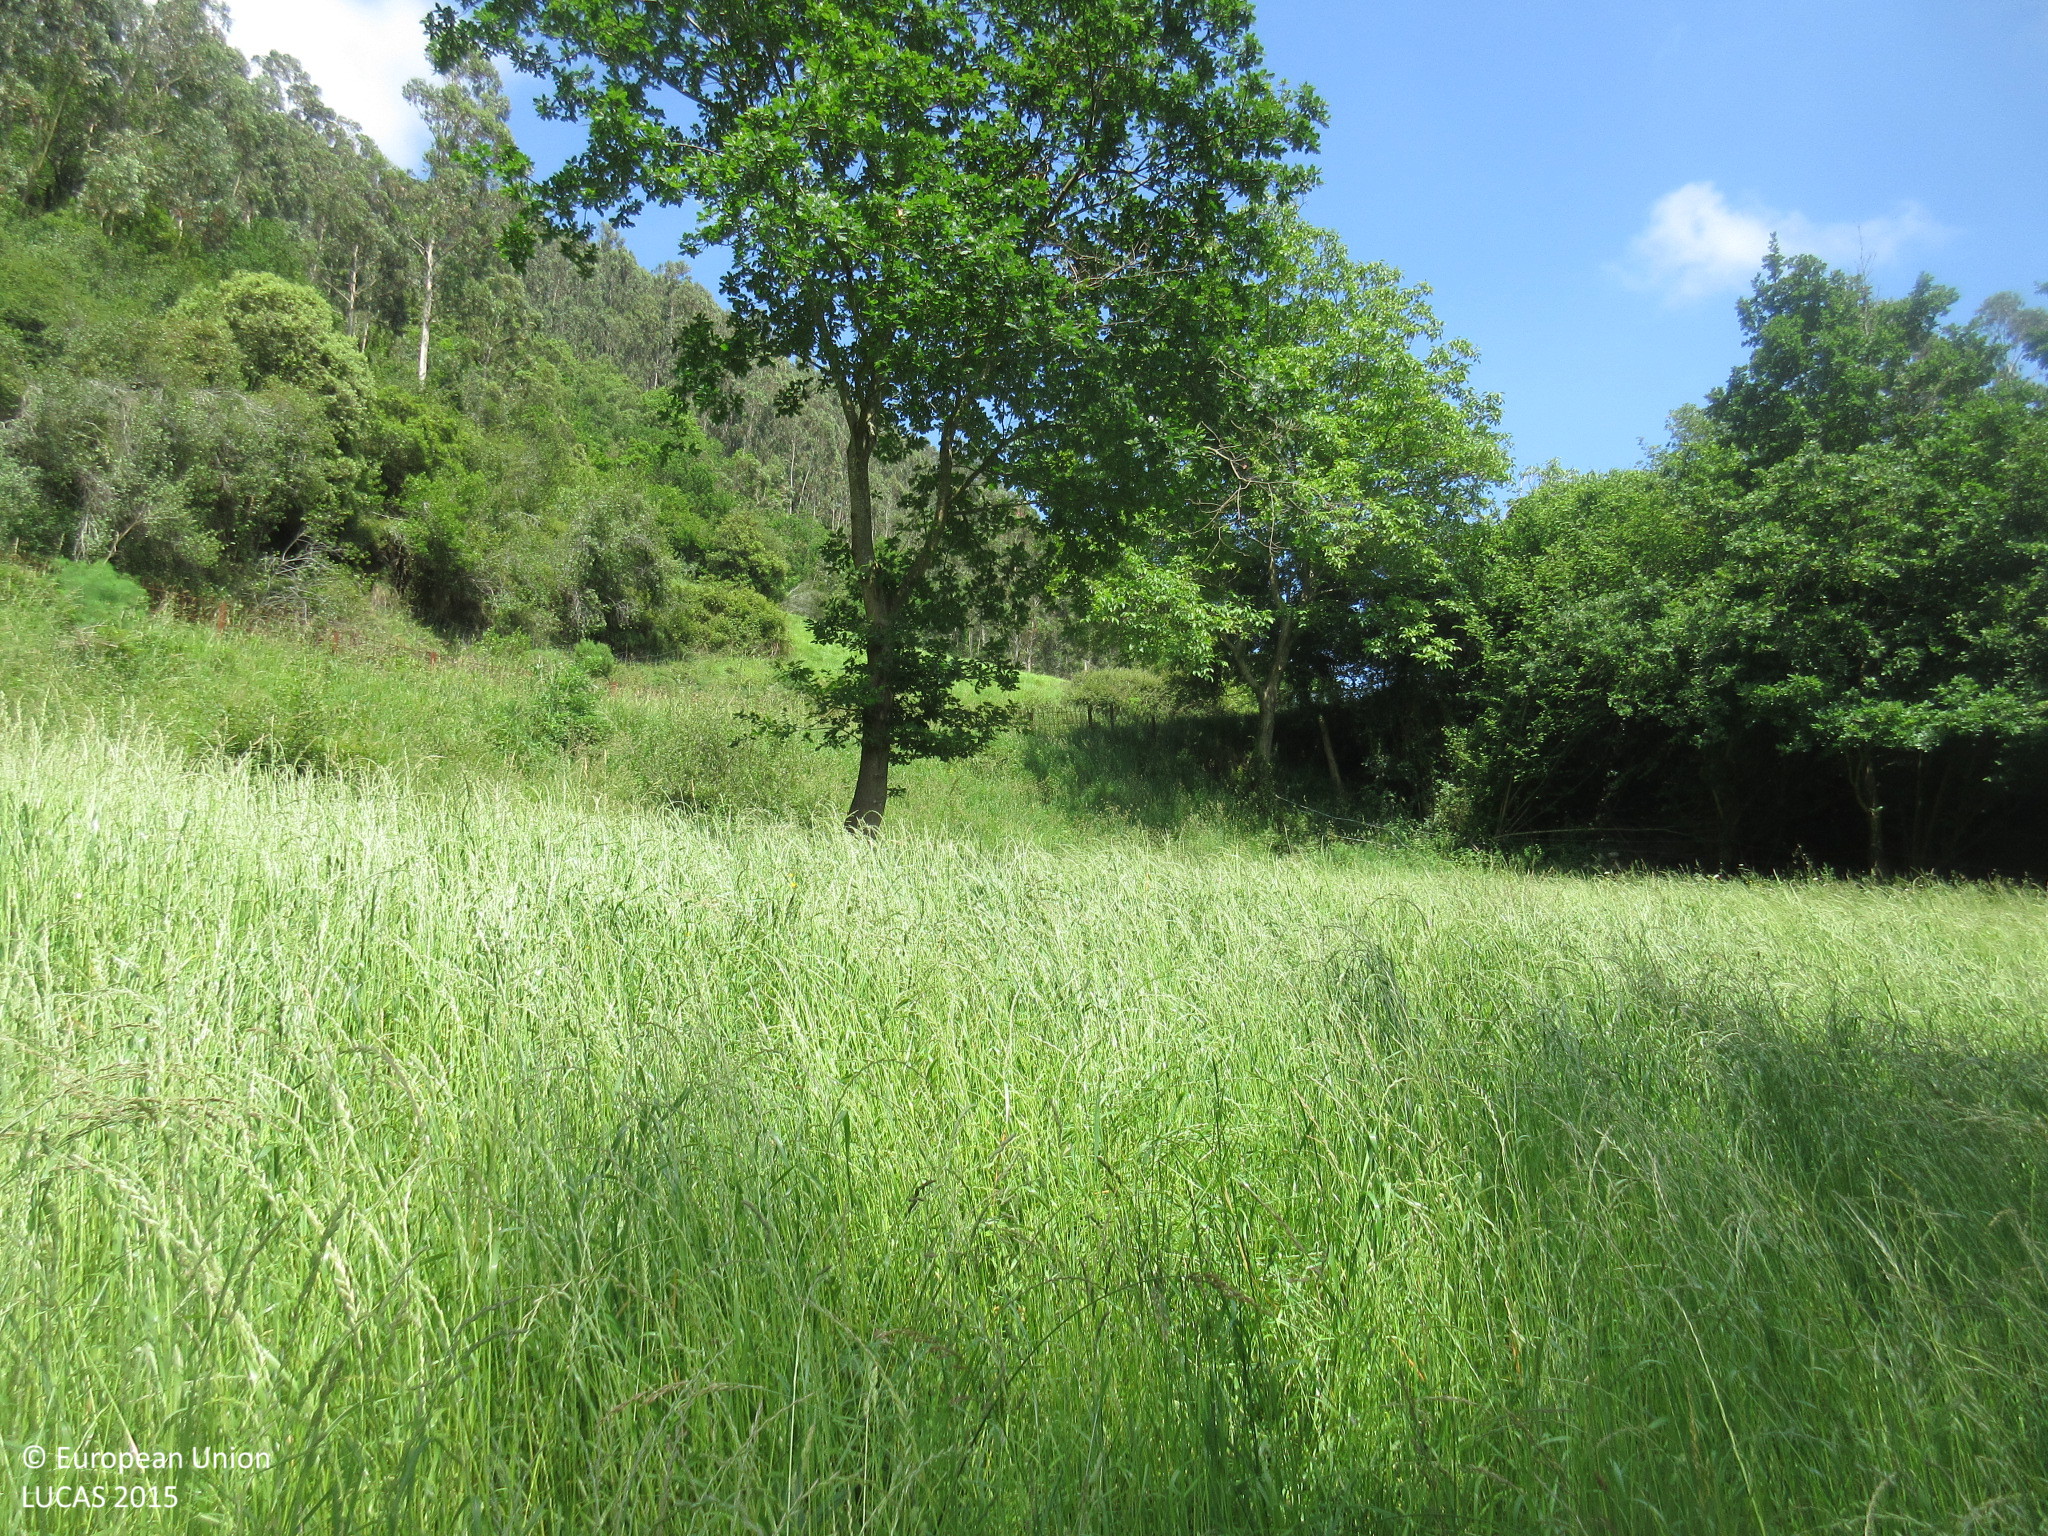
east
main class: Grassland
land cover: Grassland without tree/shrub cover
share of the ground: > 75 %
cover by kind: herbaceous plants 100 %
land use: Agriculture (excluding fallow land and kitchen gardens)
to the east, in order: Grassland without tree/shrub cover; Fences; Tracks; Grass margins; Fences; Grassland without tree/shrub cover; Abandoned hedges; Grassland without tree/shrub cover; Fences; Grassland without tree/shrub cover; Fences; Grassland without tree/shrub cover; Broadleaved woodland; Grassland with sparse tree/shrub cover
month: May
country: ES
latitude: 43.3329
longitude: -4.5779
